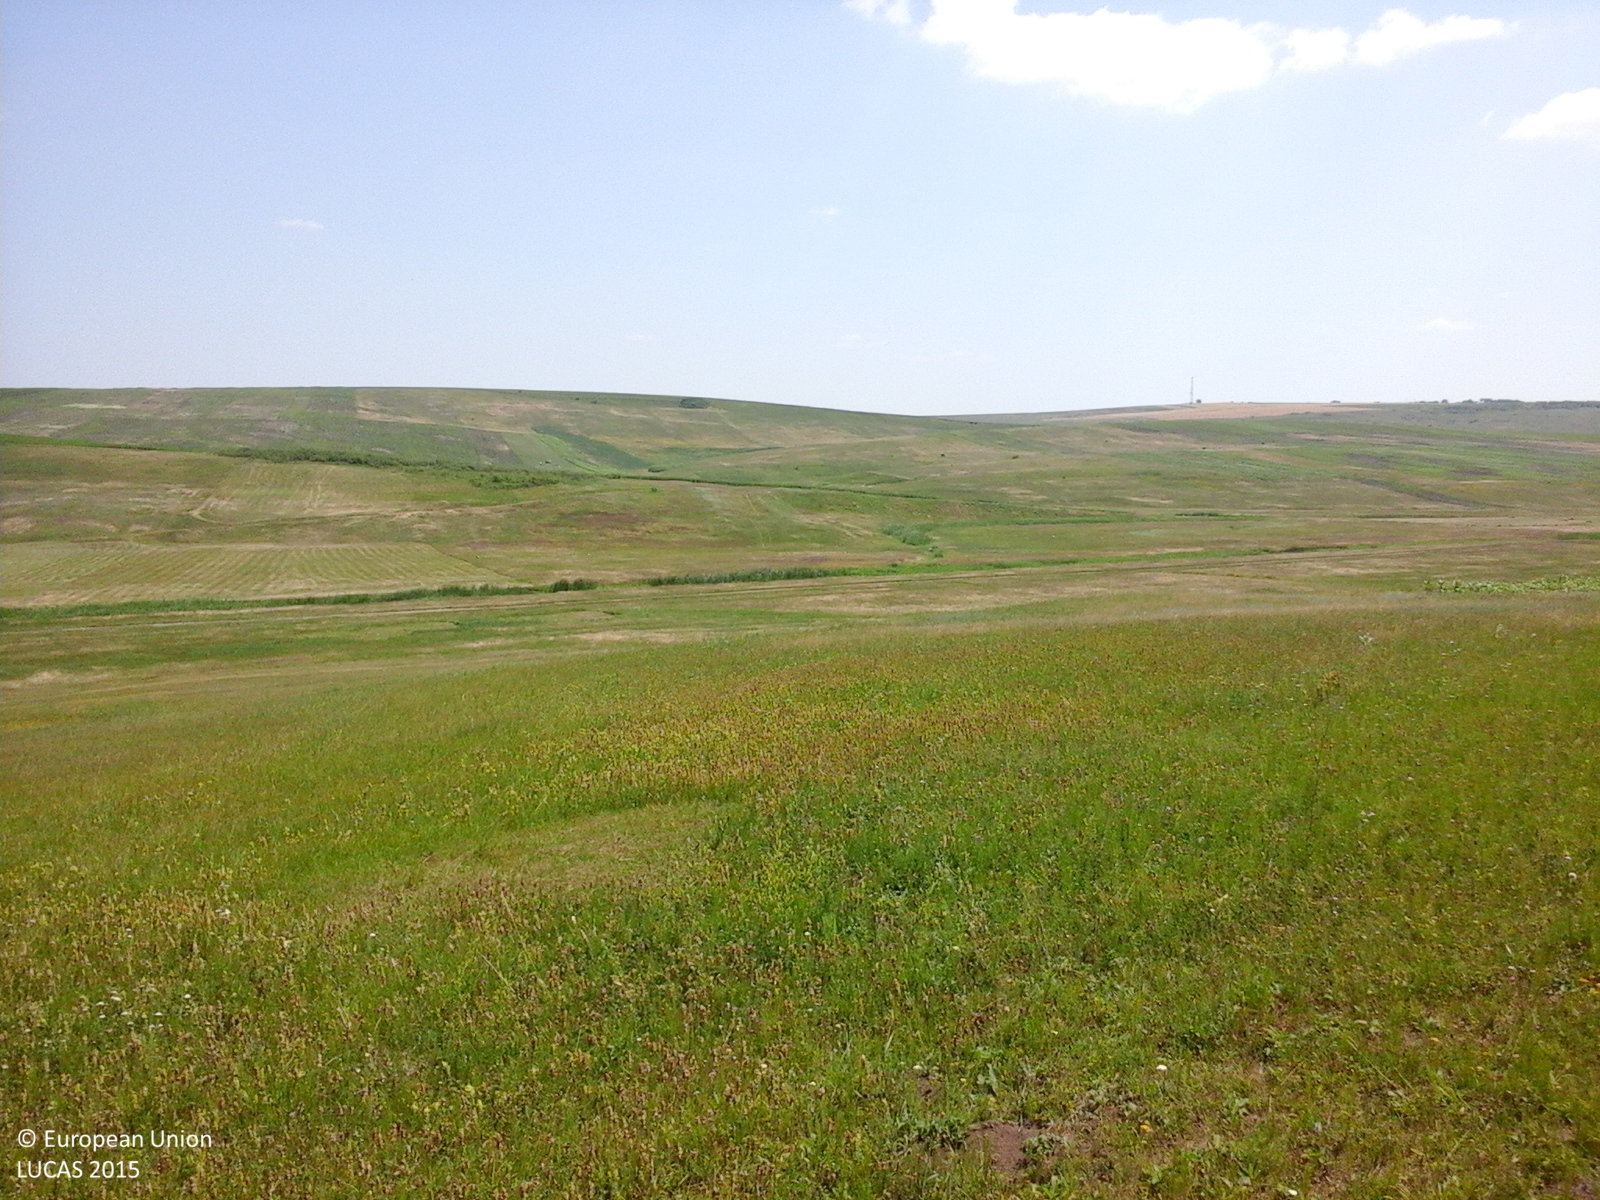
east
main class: Grassland
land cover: Grassland without tree/shrub cover
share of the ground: > 75 %
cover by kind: herbaceous plants 100 %
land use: Agriculture (excluding fallow land and kitchen gardens)
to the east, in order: Grassland without tree/shrub cover; Tracks; Grassland without tree/shrub cover; Shruby margins; Ditches and canals; Shruby margins; Spontaneously vegetated surfaces
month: June
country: RO
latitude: 47.1720
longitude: 27.1920
